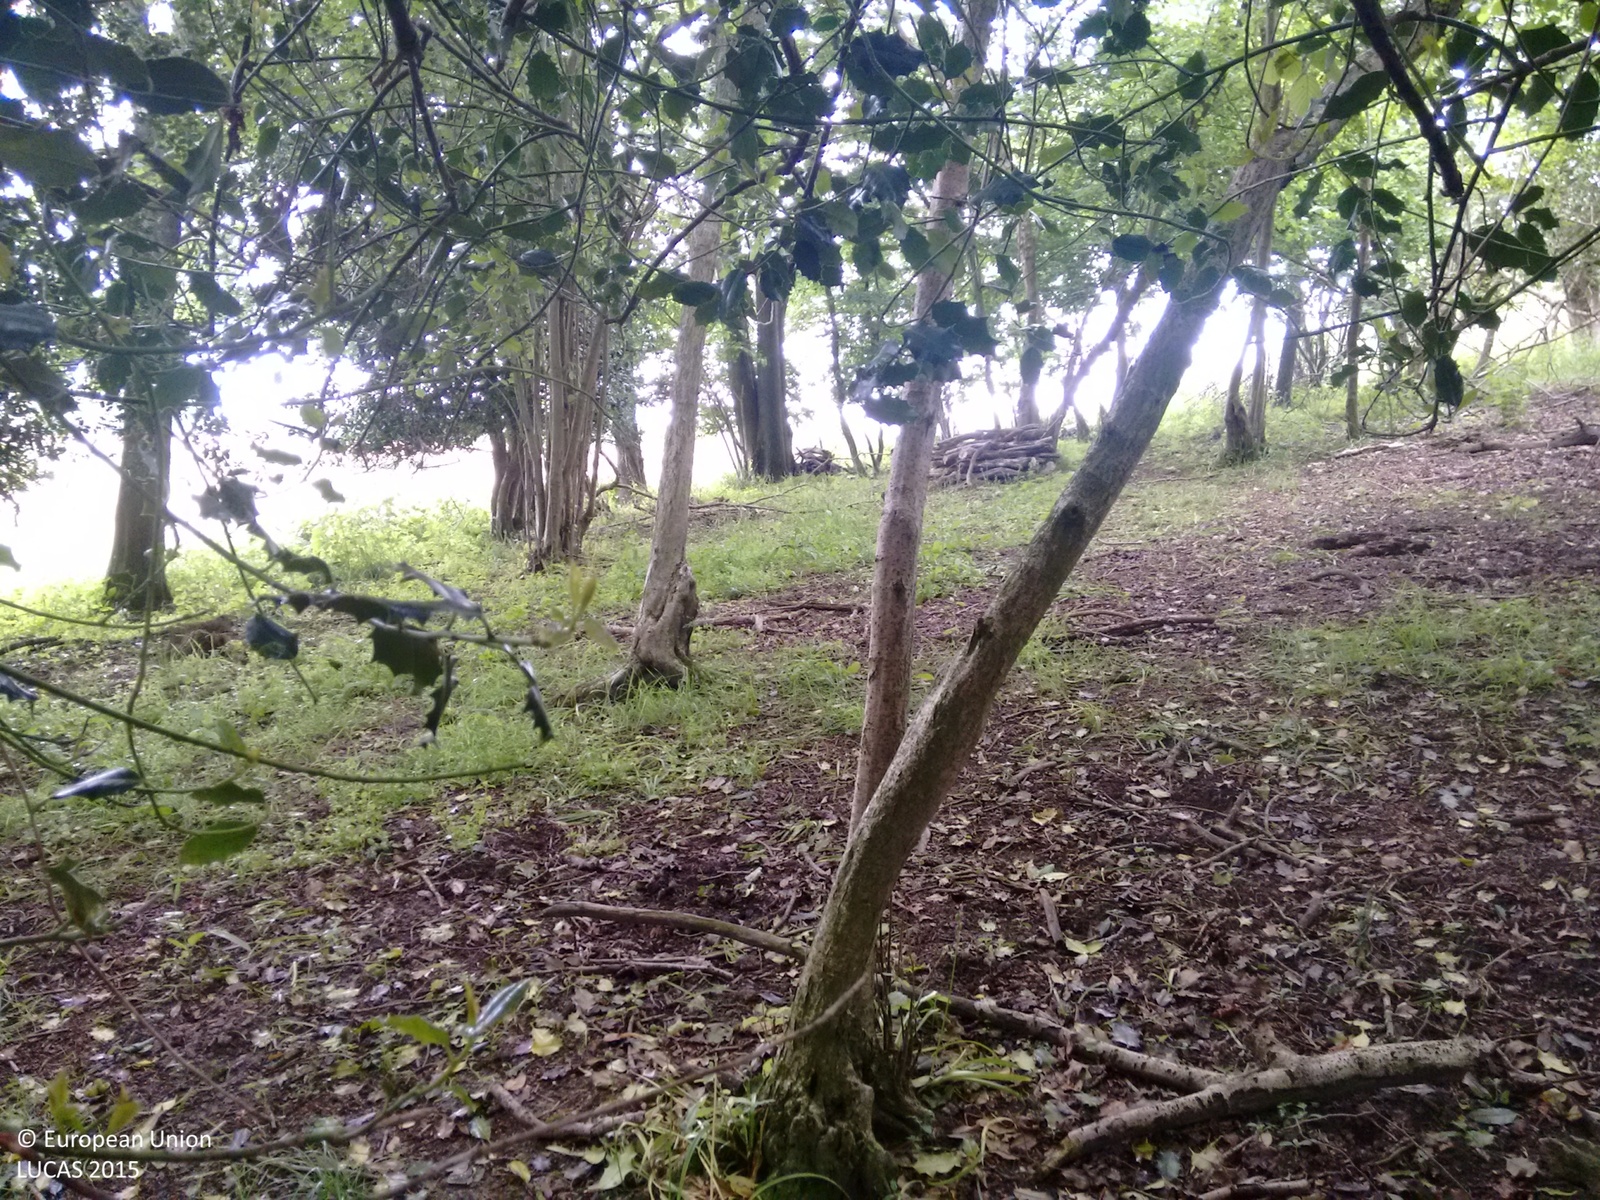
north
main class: Woodland
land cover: Broadleaved woodland
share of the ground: > 75 %
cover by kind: broadleaved forest trees 90 %, shrubs 10 %
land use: Semi-natural and natural areas not in use
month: June
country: GB
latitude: 50.9523
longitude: 0.3622
